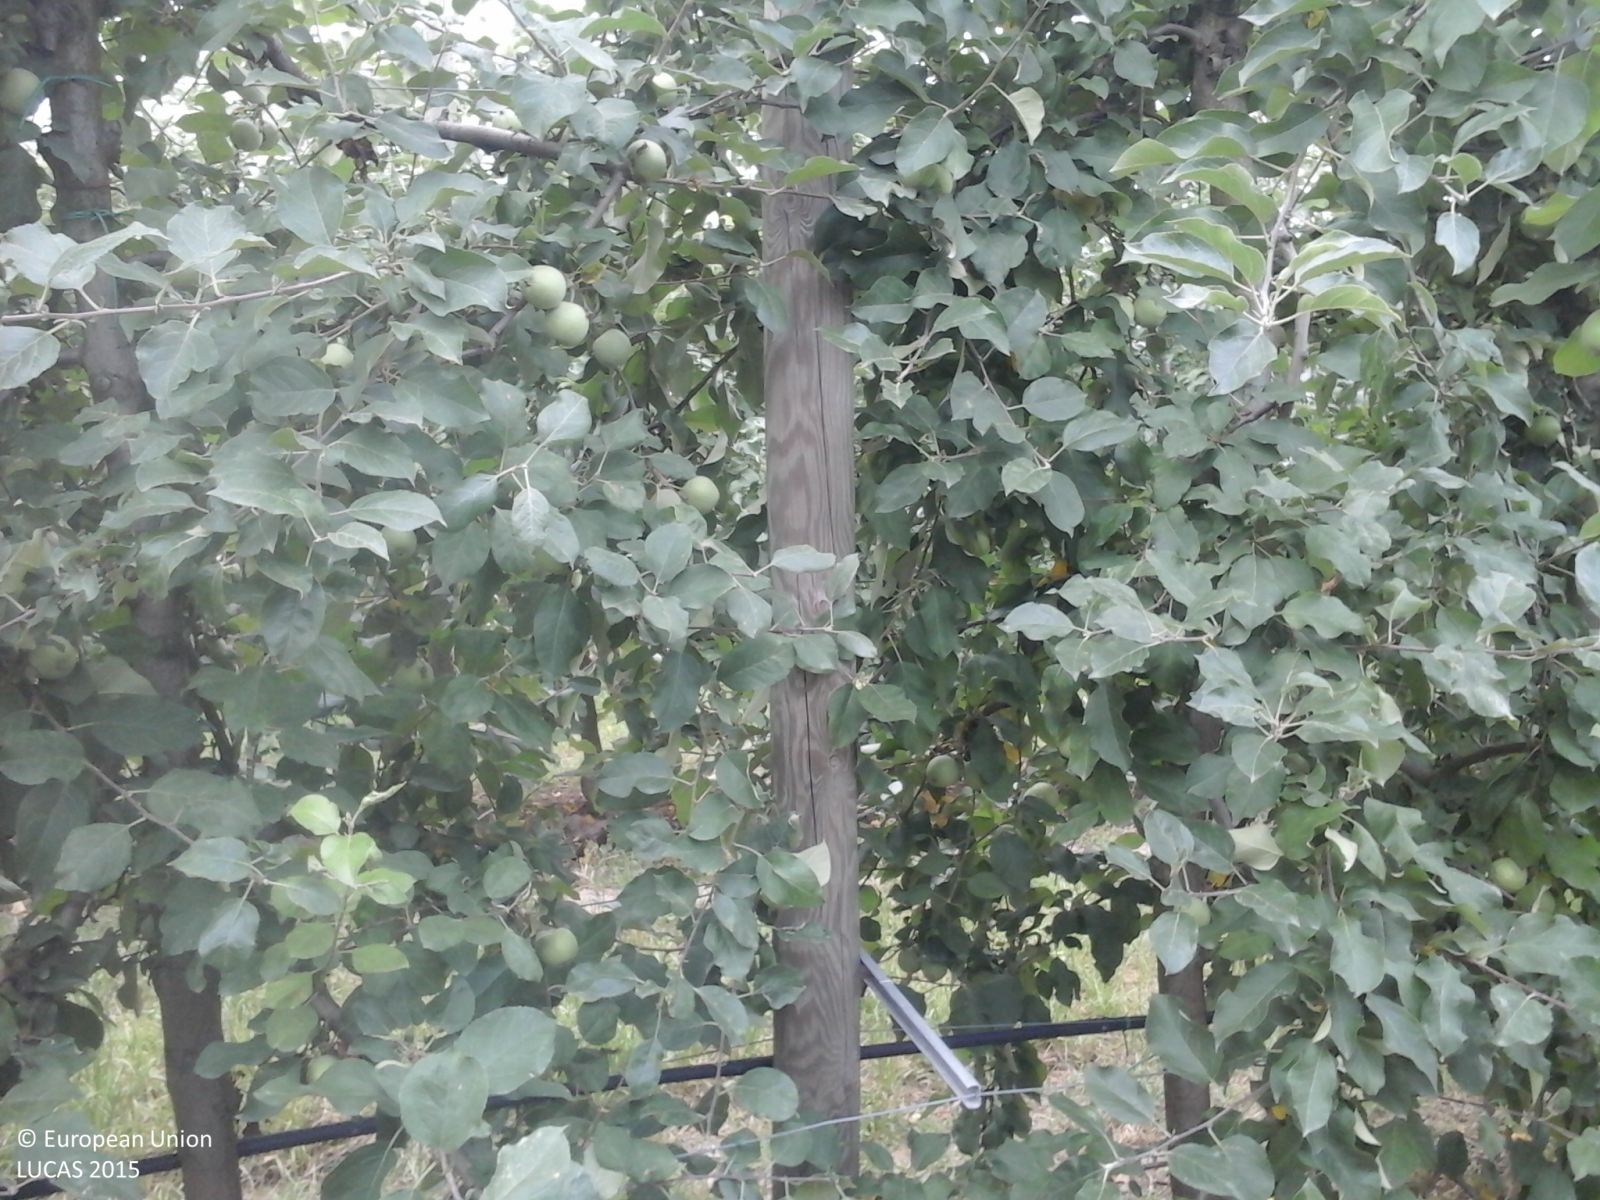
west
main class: Cropland
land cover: Apple fruit
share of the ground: > 75 %
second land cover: Grassland without tree/shrub cover
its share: > 75 %
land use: Agriculture (excluding fallow land and kitchen gardens)
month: June
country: IT
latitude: 44.7773
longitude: 11.1224
